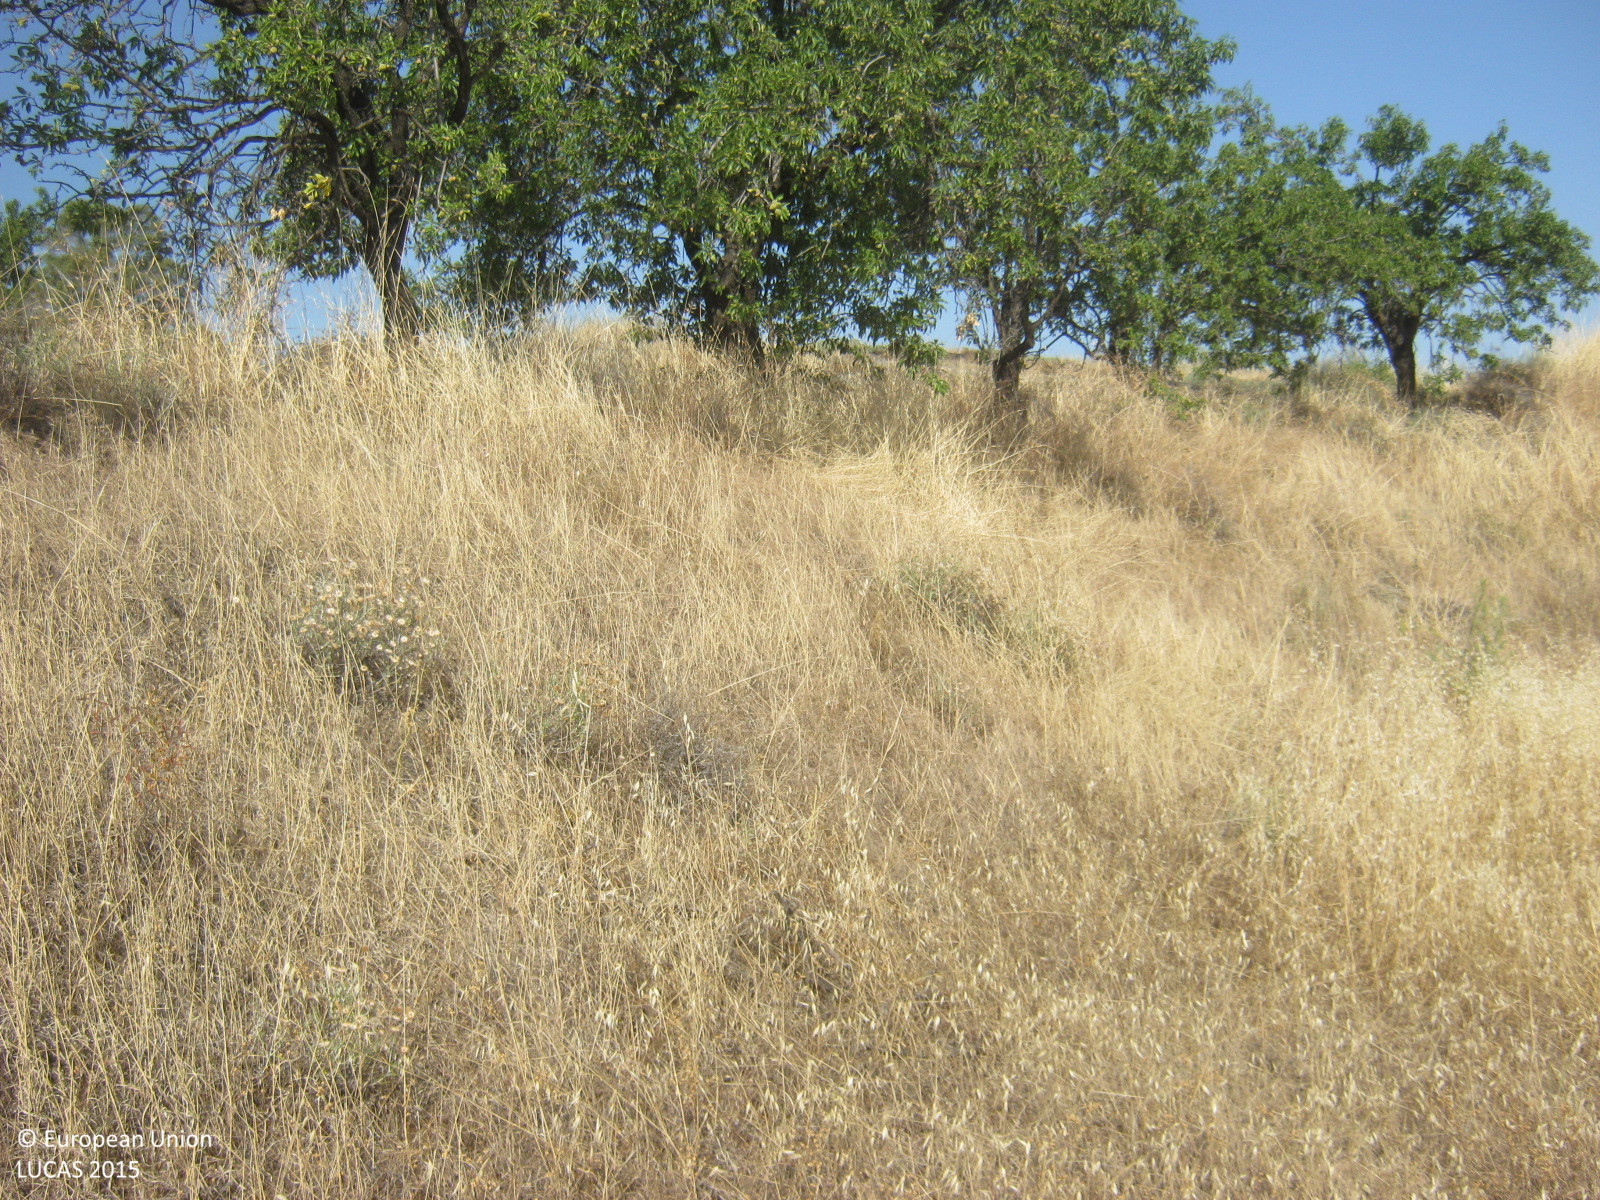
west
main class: Cropland
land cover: Nuts trees
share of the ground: 10 - 25 %
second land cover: Spontaneously vegetated surfaces
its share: > 75 %
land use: Agriculture (excluding fallow land and kitchen gardens)
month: May
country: CY
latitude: 35.0757
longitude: 32.9984
